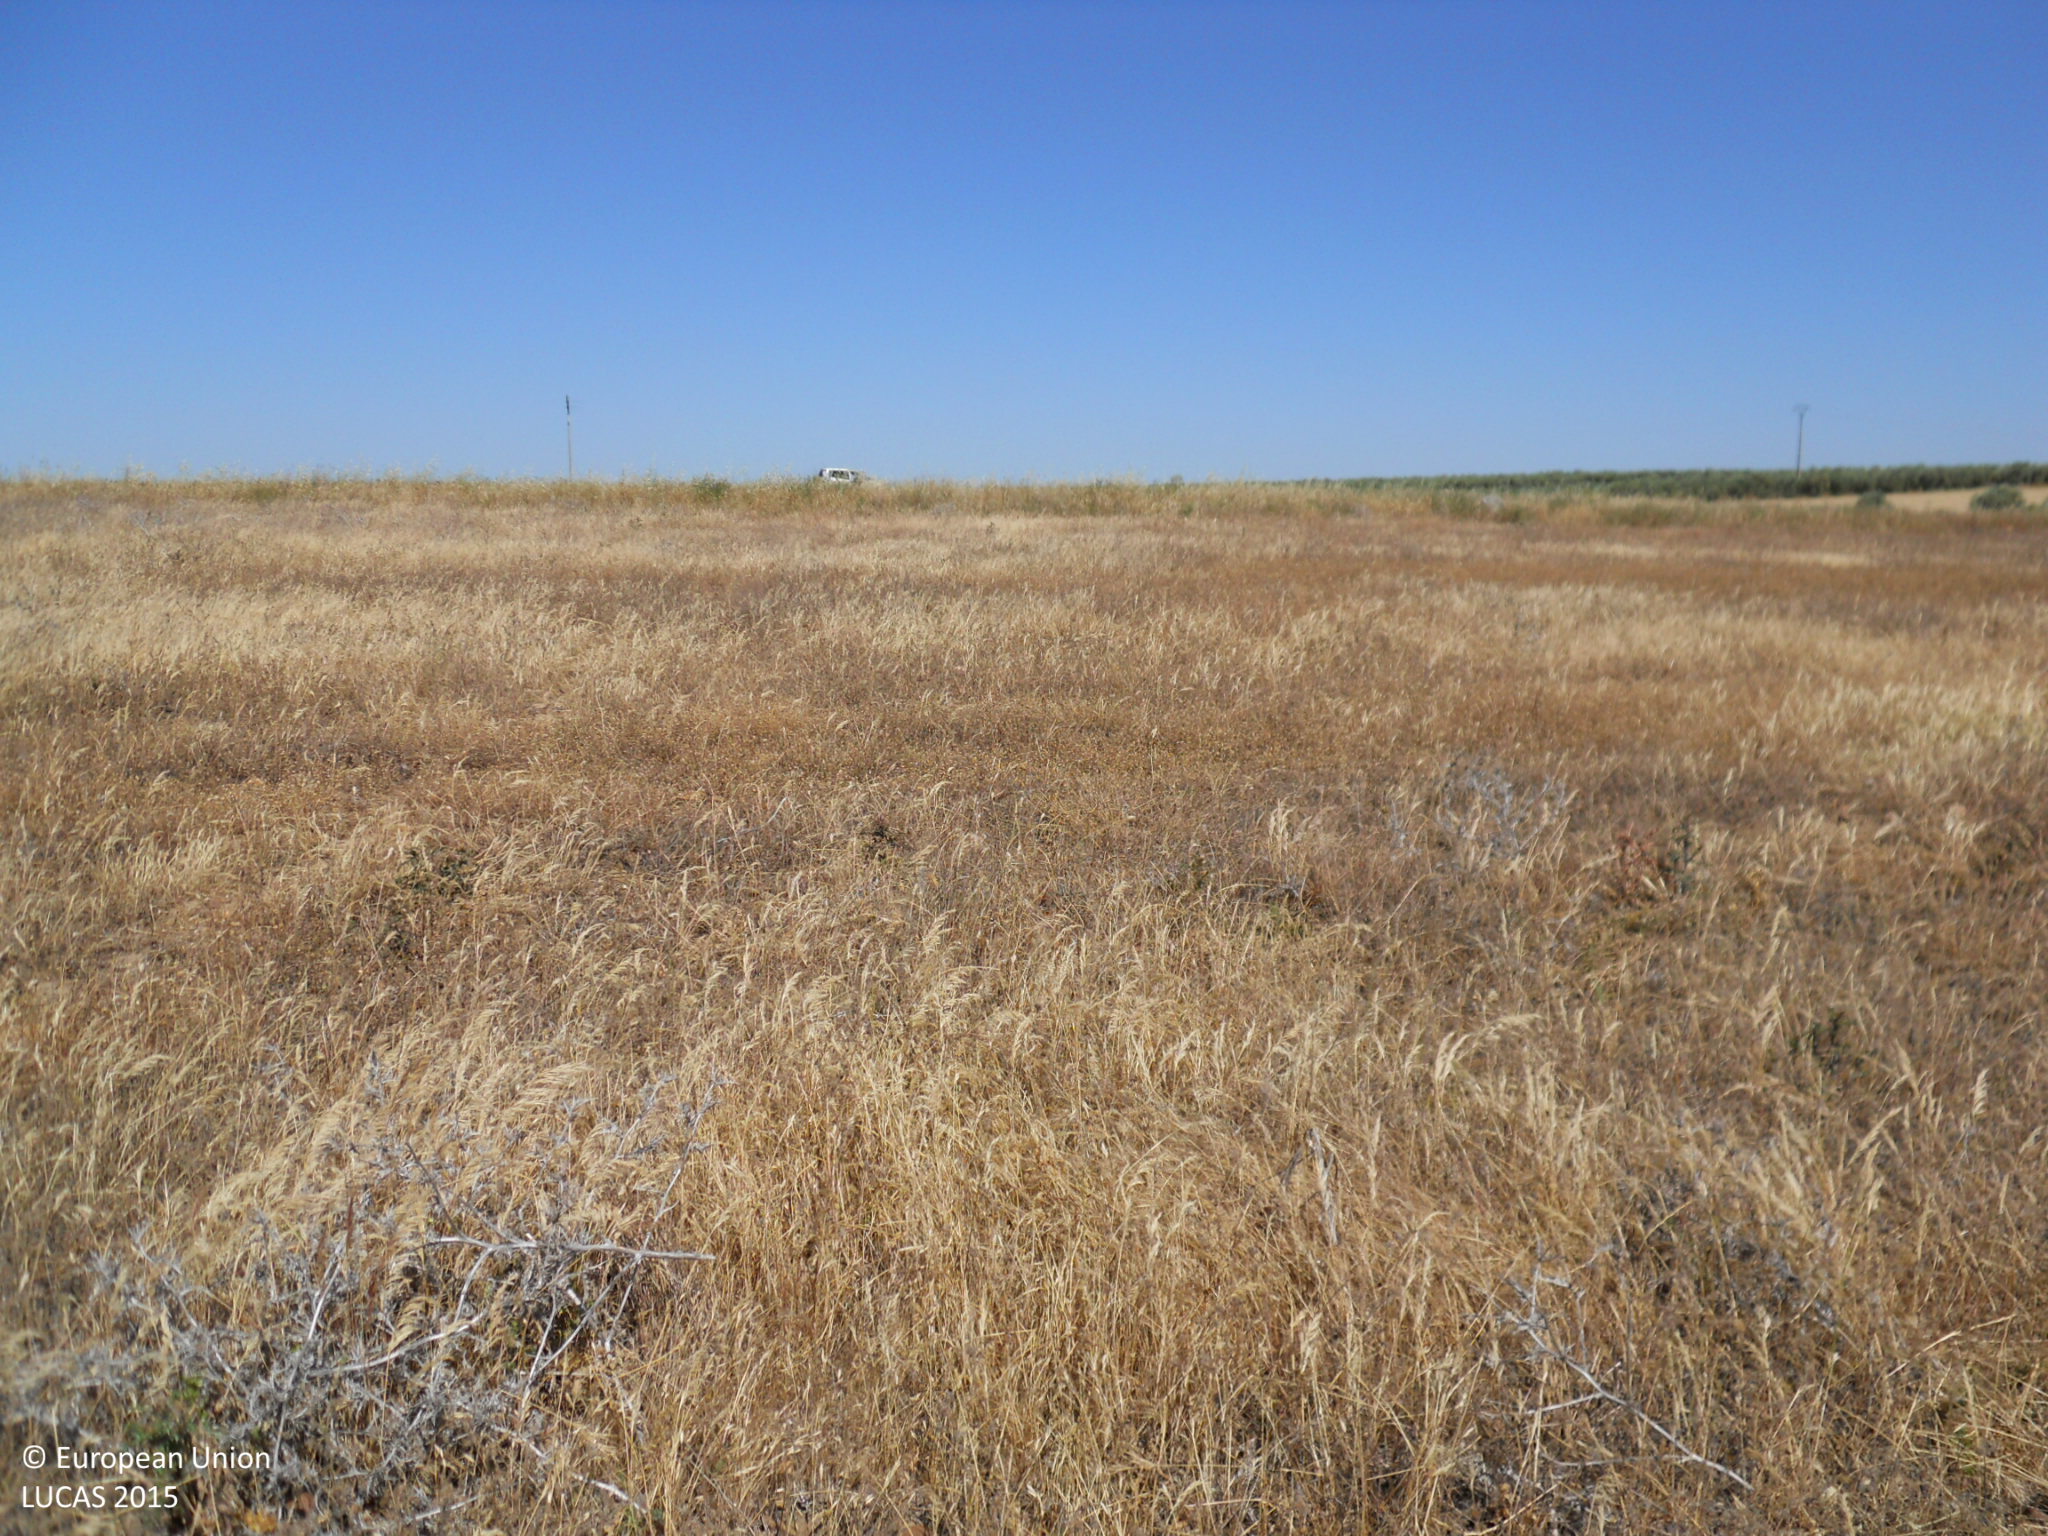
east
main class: Grassland
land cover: Grassland without tree/shrub cover
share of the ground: 50 - 75 %
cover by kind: herbaceous plants 100 %
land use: Agriculture (excluding fallow land and kitchen gardens)
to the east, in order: Grassland without tree/shrub cover; Grass margins; Grassland without tree/shrub cover; Tracks; Sunflower
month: May
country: ES
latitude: 38.9719
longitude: -6.2740
